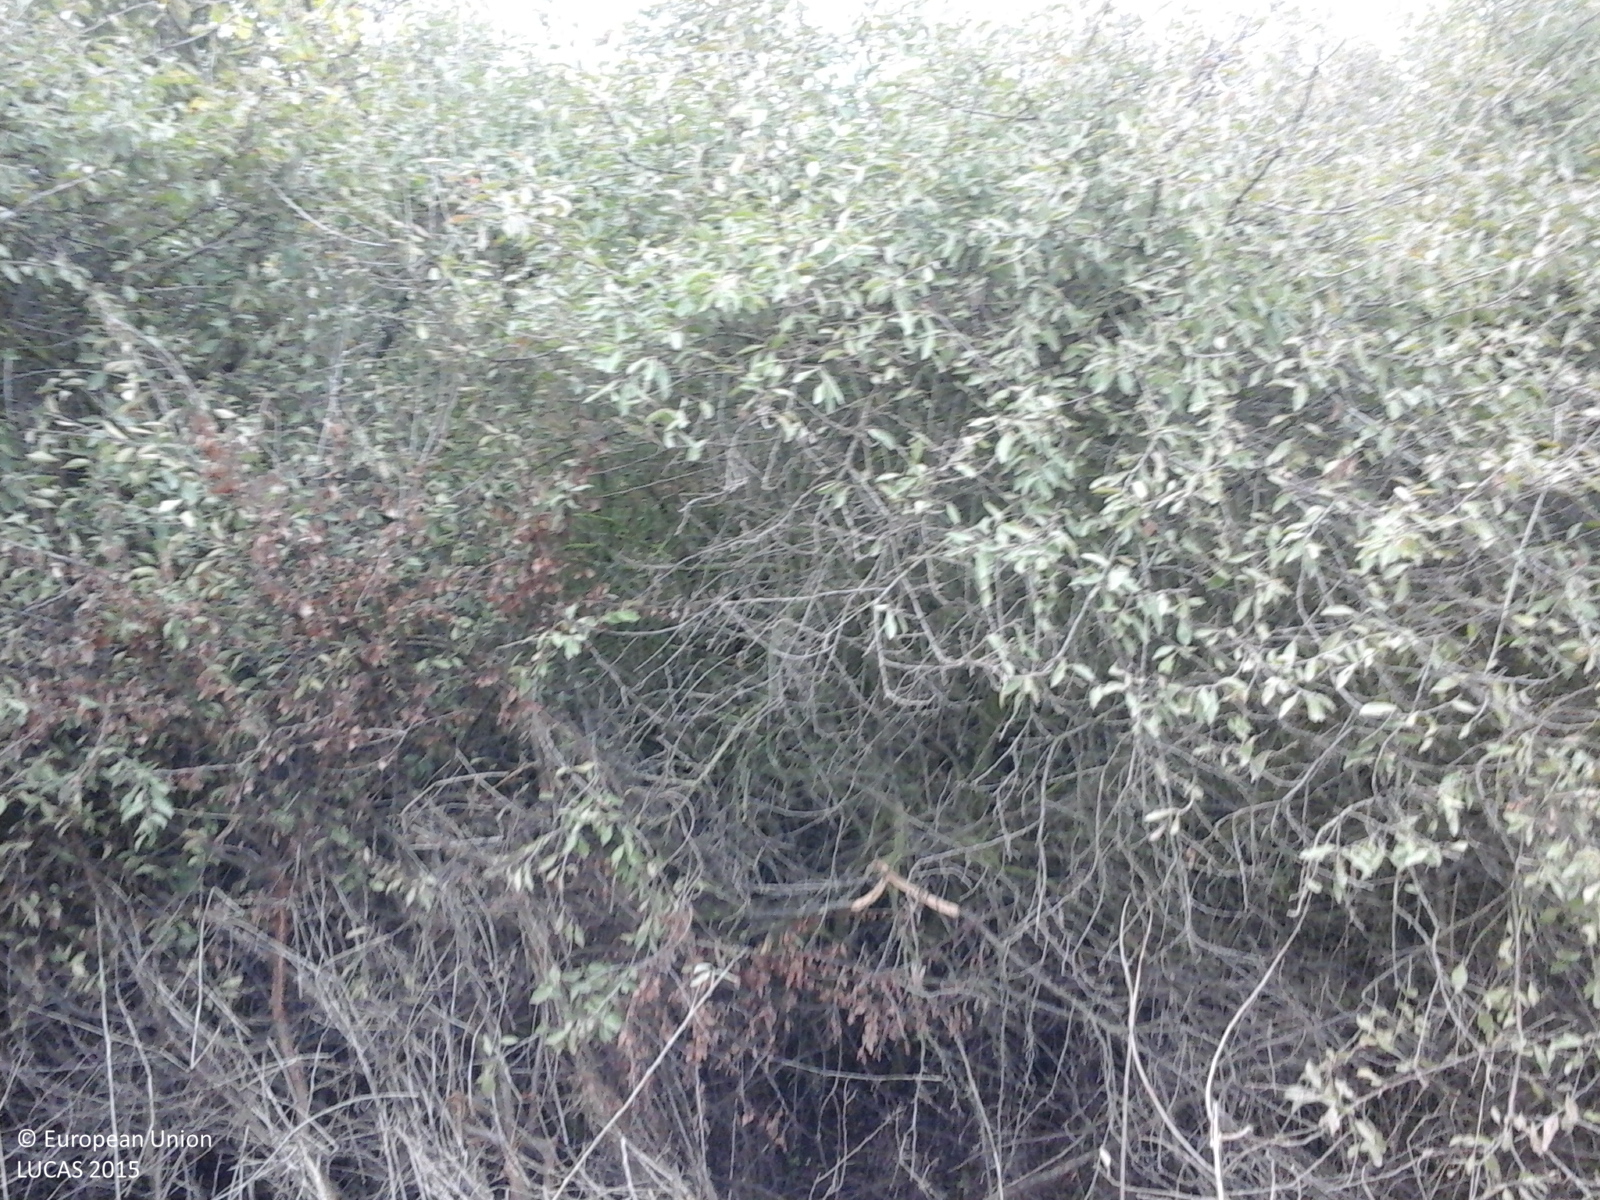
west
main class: Shrubland
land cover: Shrubland with sparse tree cover
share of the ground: > 75 %
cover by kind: shrubs 95 %, broadleaved forest trees 5 %
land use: Semi-natural and natural areas not in use
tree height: < 5 m
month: October
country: RO
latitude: 45.9110
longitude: 23.3528
